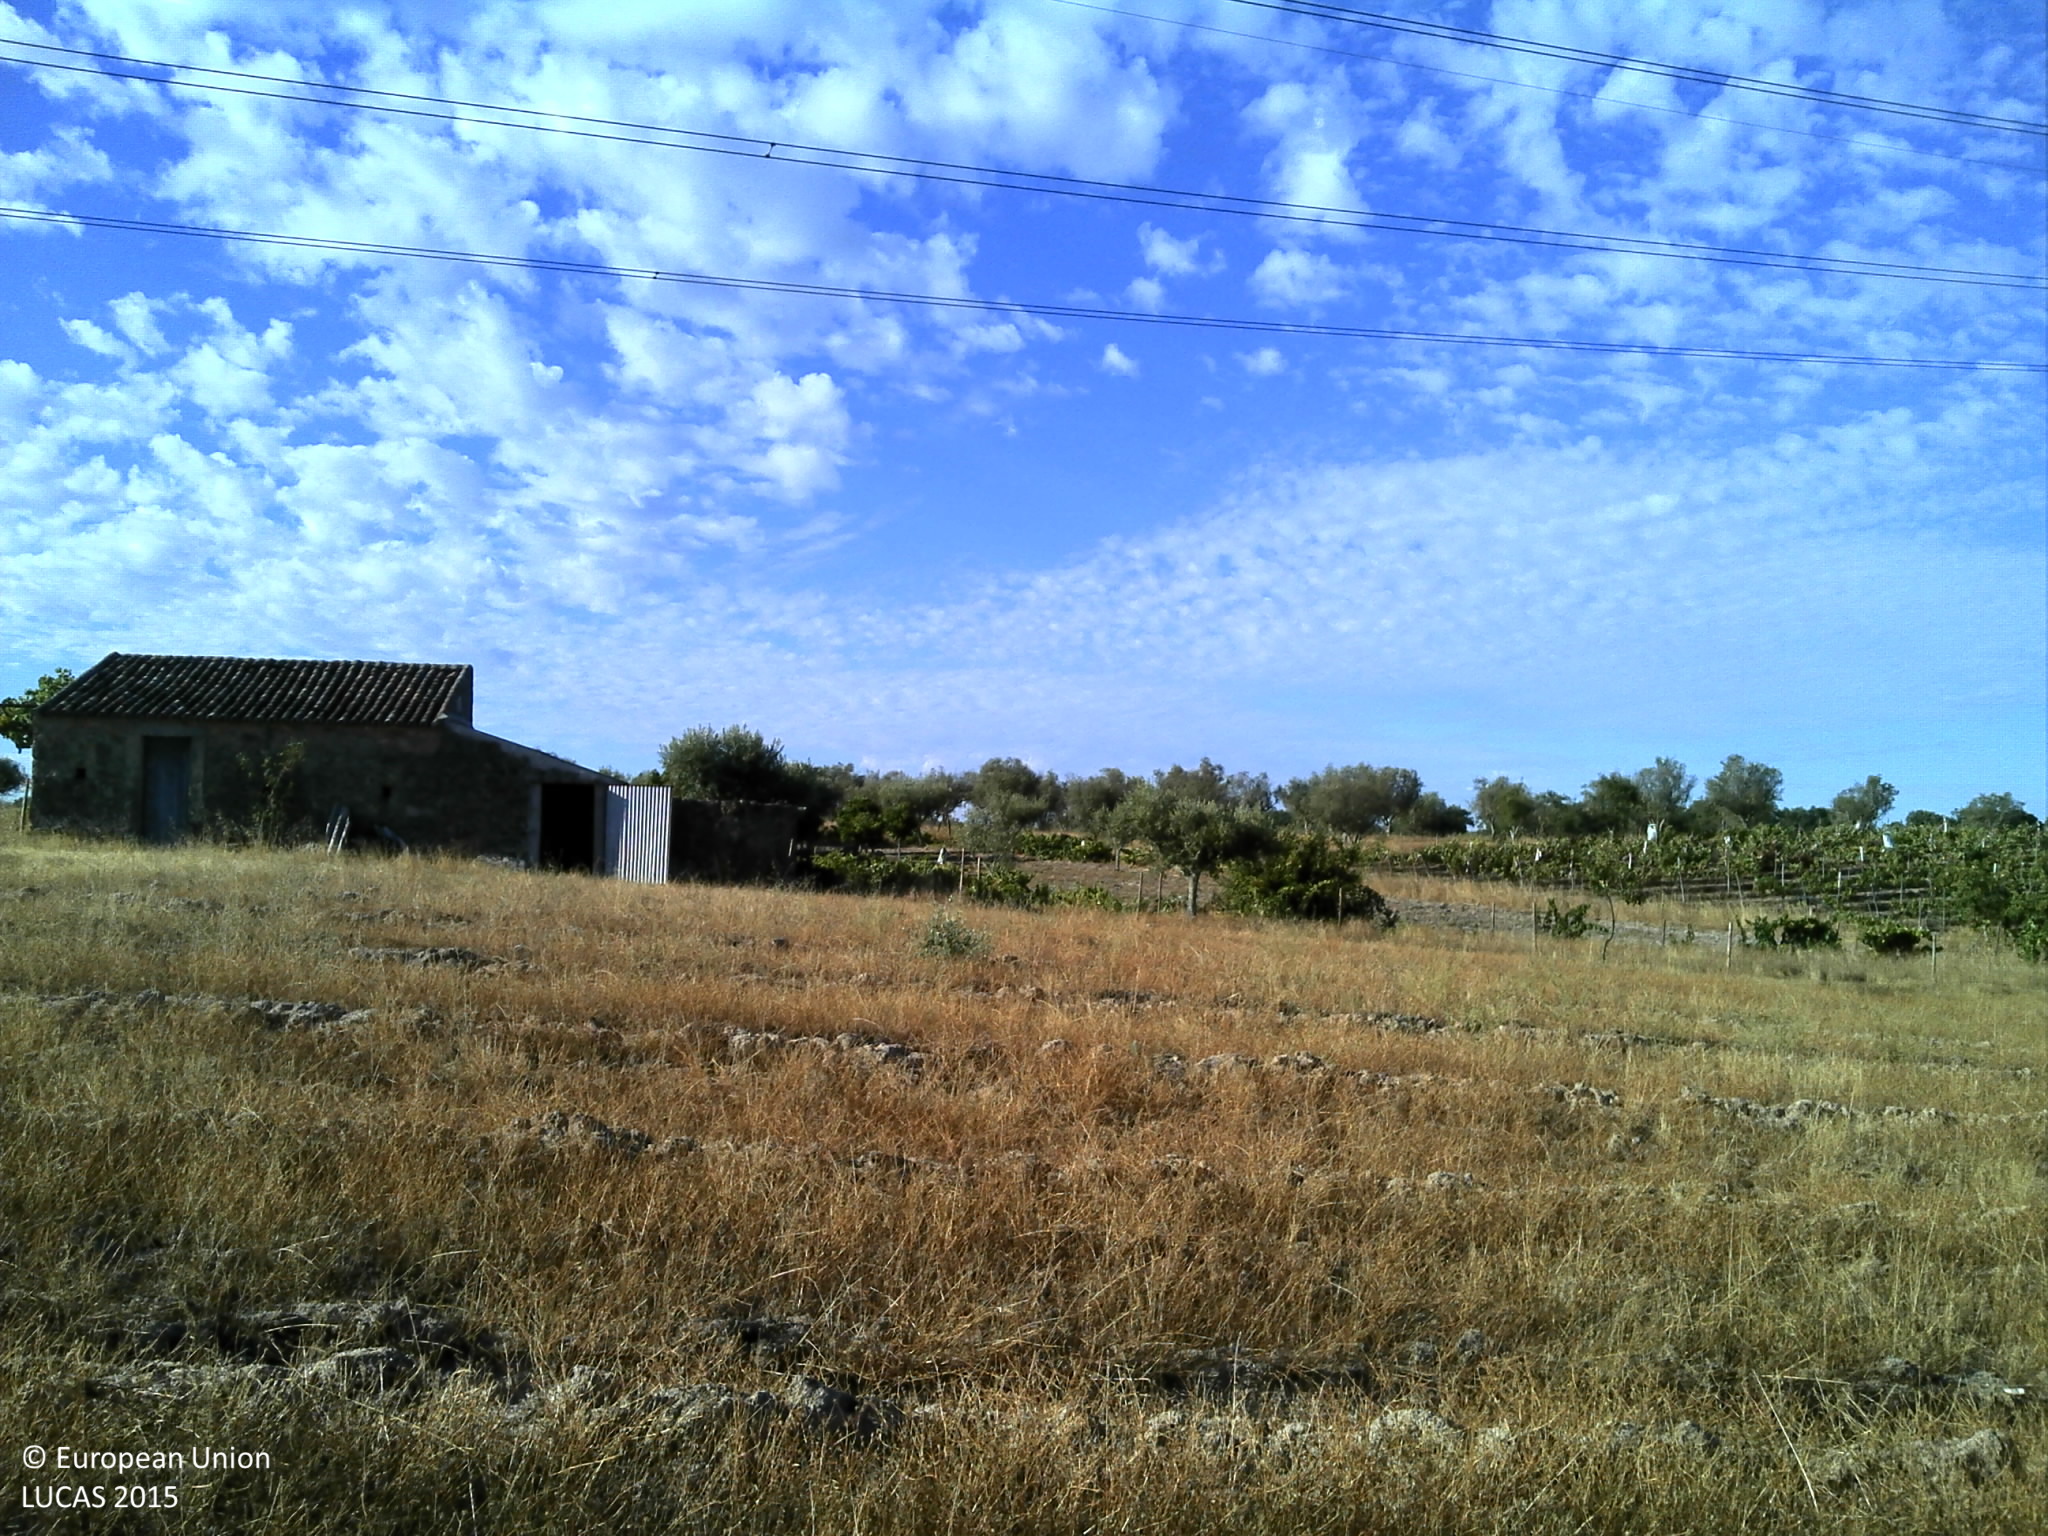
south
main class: Grassland
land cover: Grassland with sparse tree/shrub cover
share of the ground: < 10 %
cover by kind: herbaceous plants 60 %, unconsolidated bare surface 35 %, coniferous forest trees 5 %
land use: Forestry
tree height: < 5 m
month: August
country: PT
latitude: 39.5257
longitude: -7.7236
